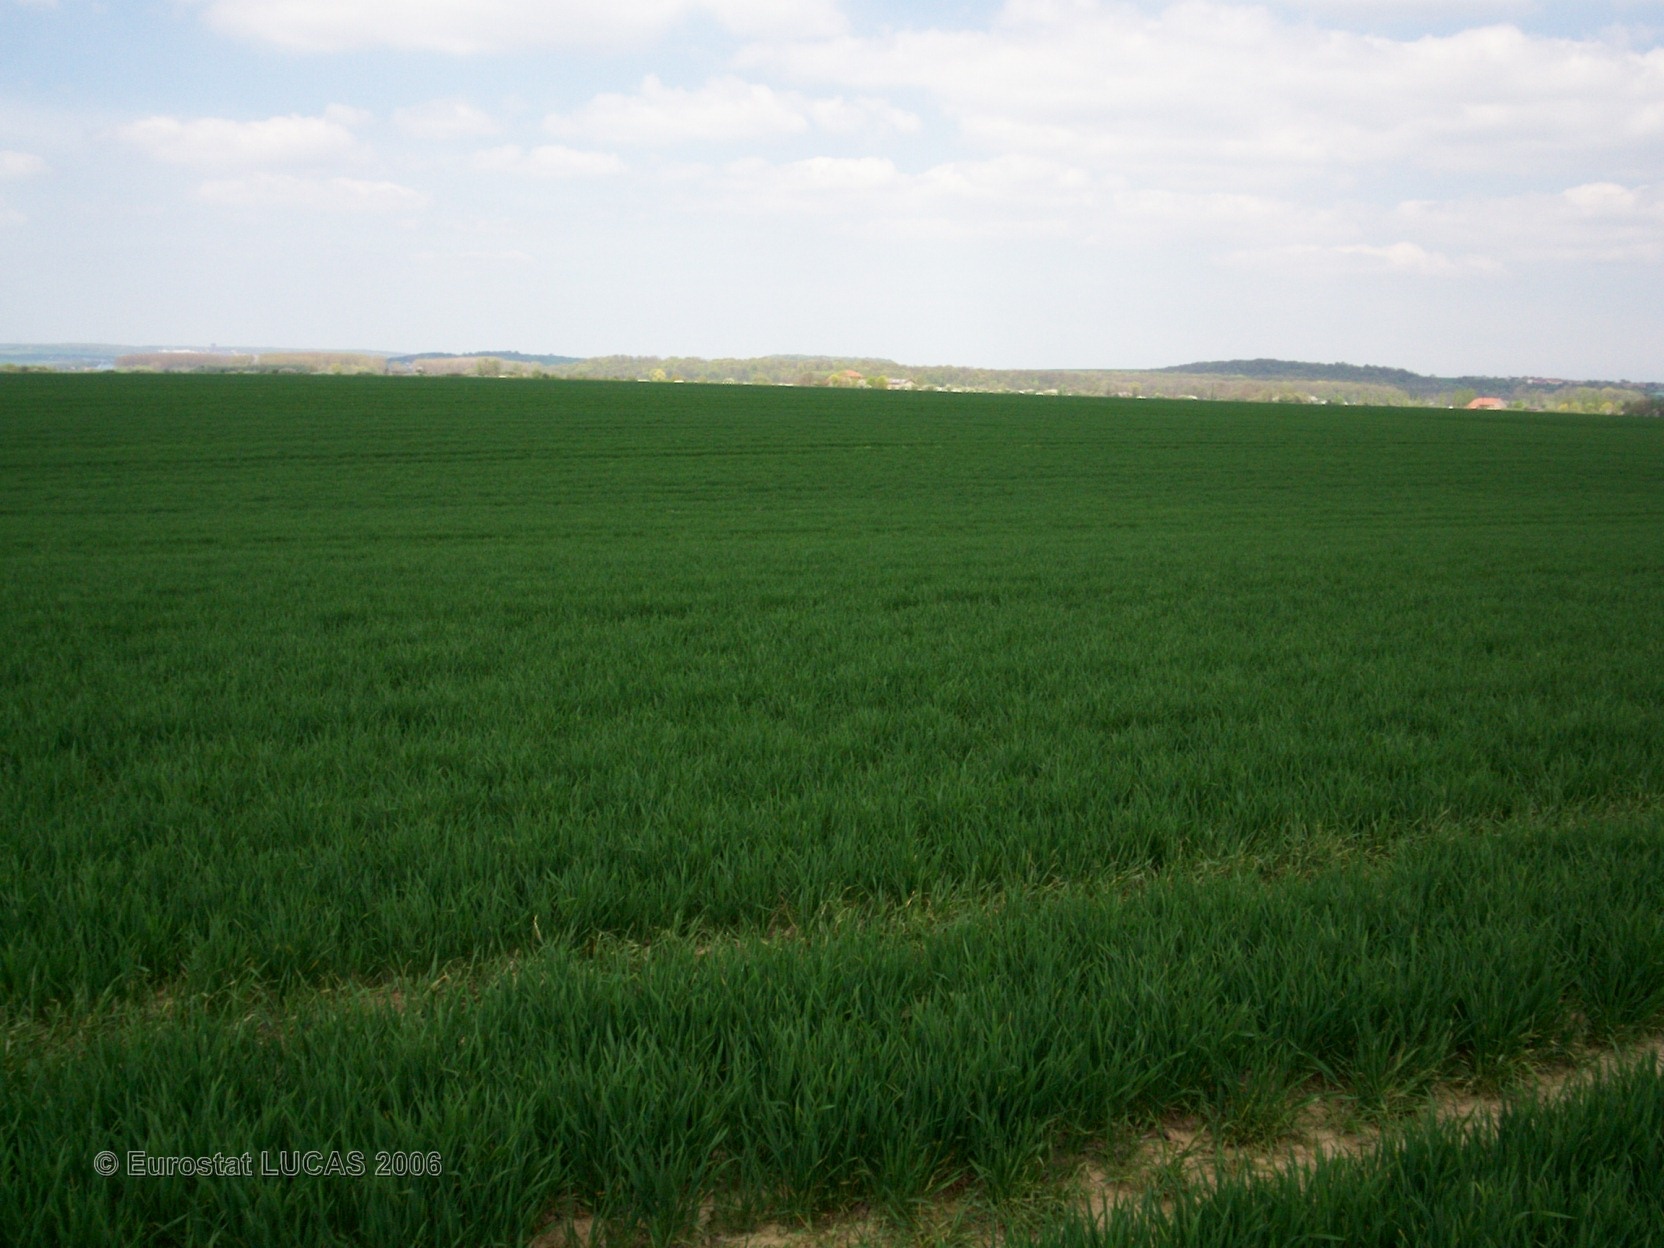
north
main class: Cropland
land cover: Common wheat
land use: Agriculture (excluding fallow land and kitchen gardens)
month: April
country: FR
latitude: 49.0035
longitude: 6.7332
